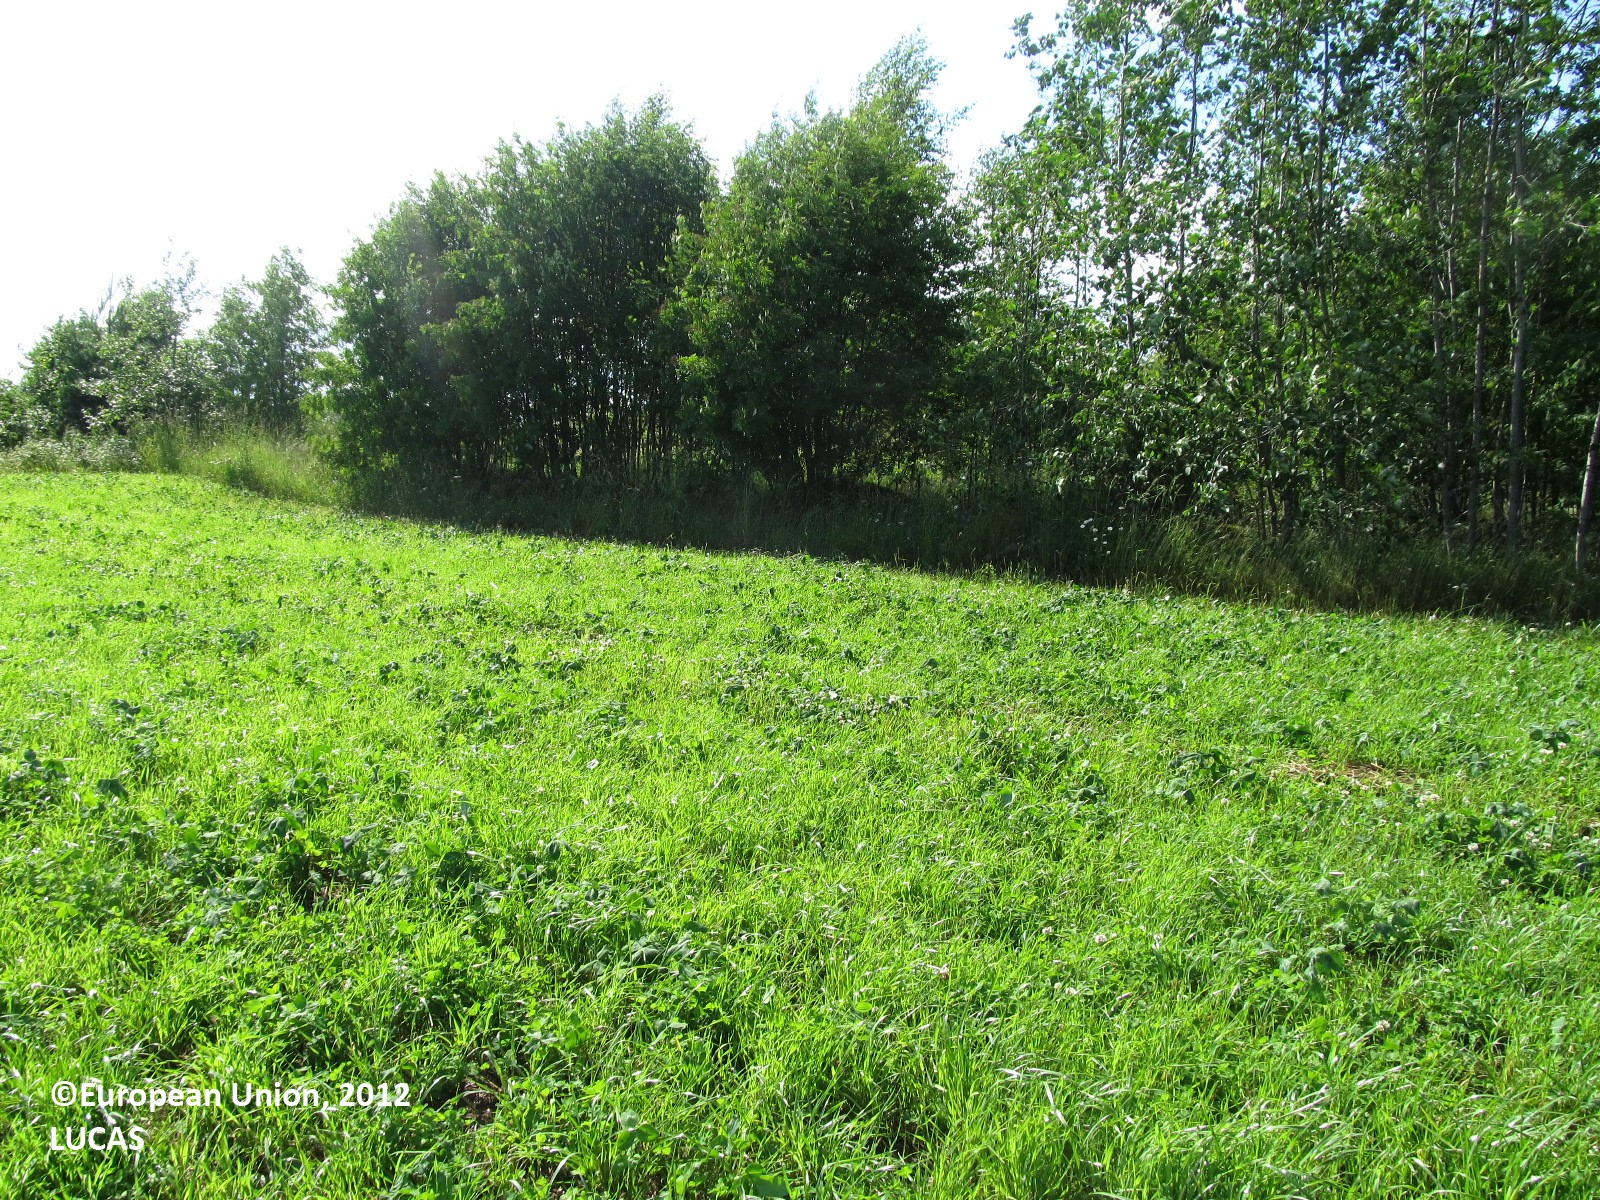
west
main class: Grassland
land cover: Spontaneously vegetated surfaces
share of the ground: > 75 %
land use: Agriculture (excluding fallow land and kitchen gardens)
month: July
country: FI
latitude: 61.9230
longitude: 28.4318
